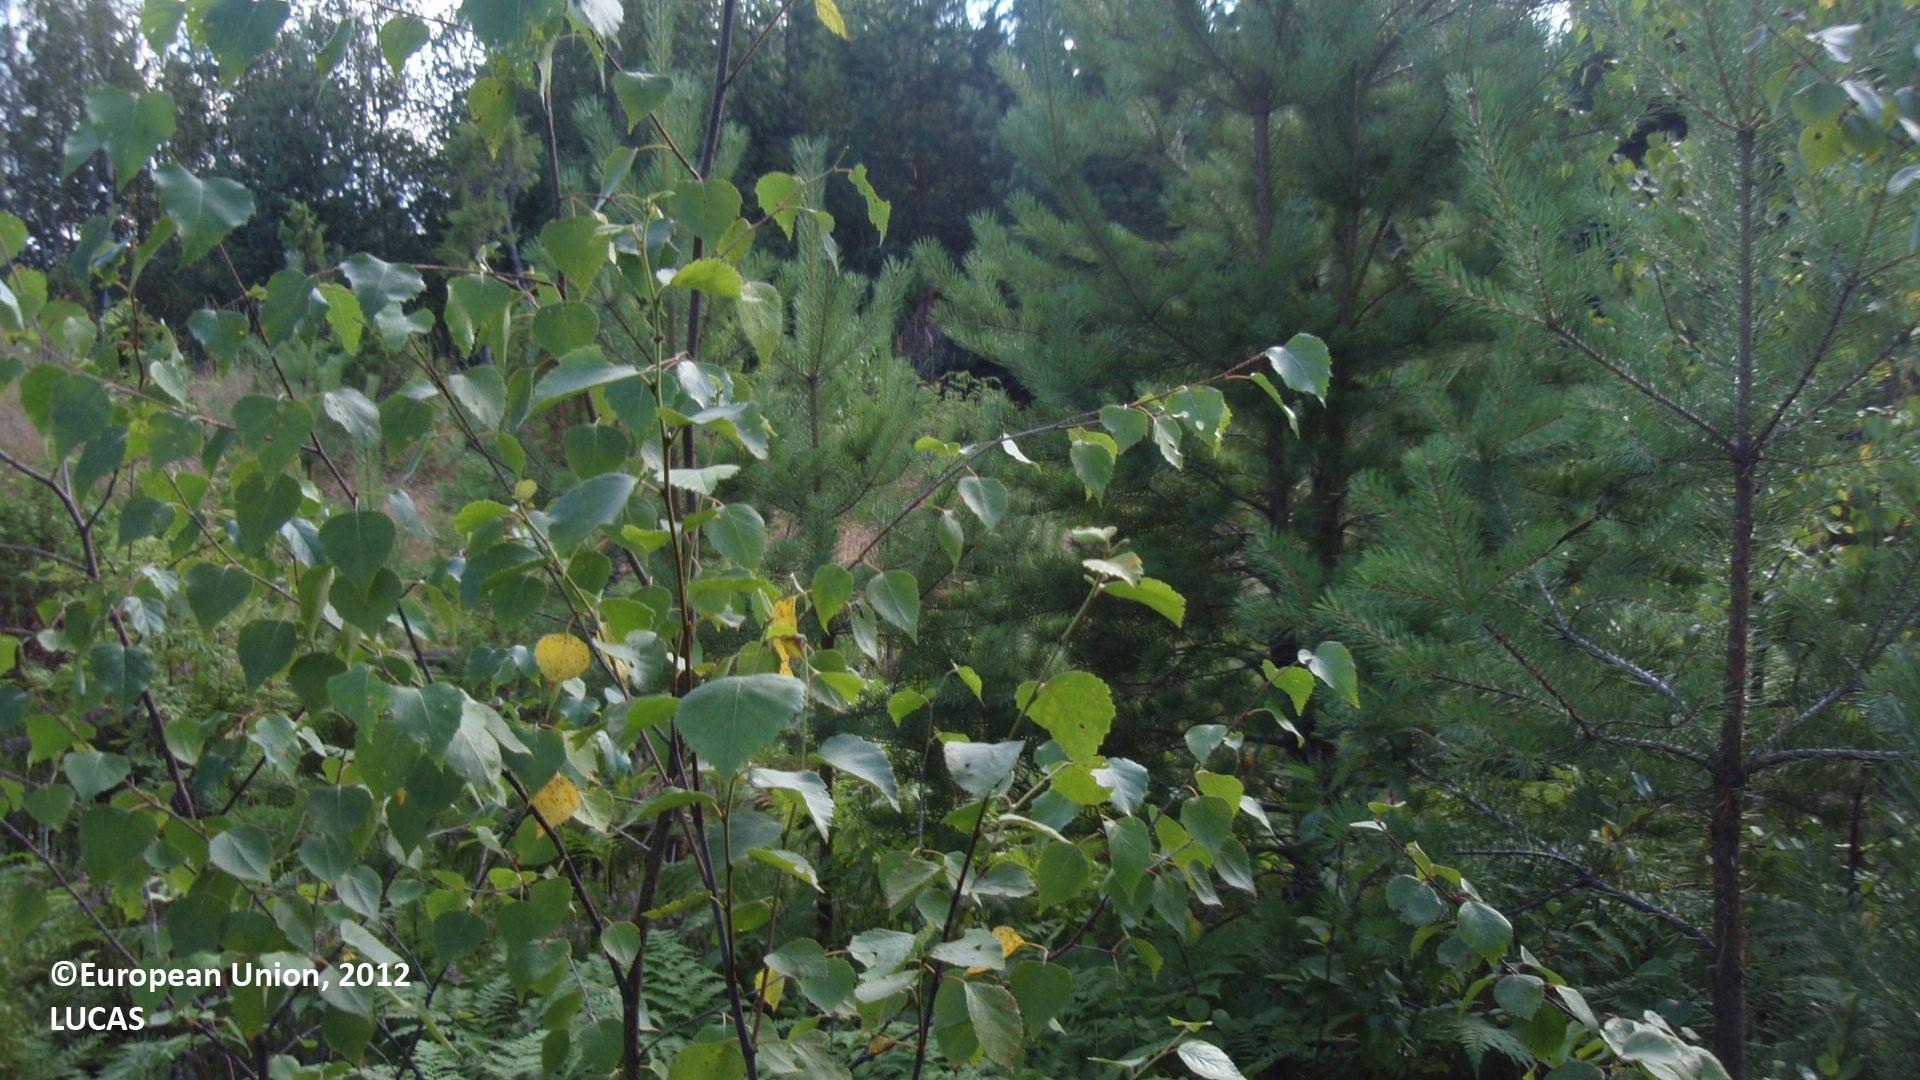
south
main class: Woodland
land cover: Pine dominated mixed woodland
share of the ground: 25 - 50 %
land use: Forestry
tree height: < 5 m
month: July
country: FI
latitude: 61.1605
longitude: 28.1364
